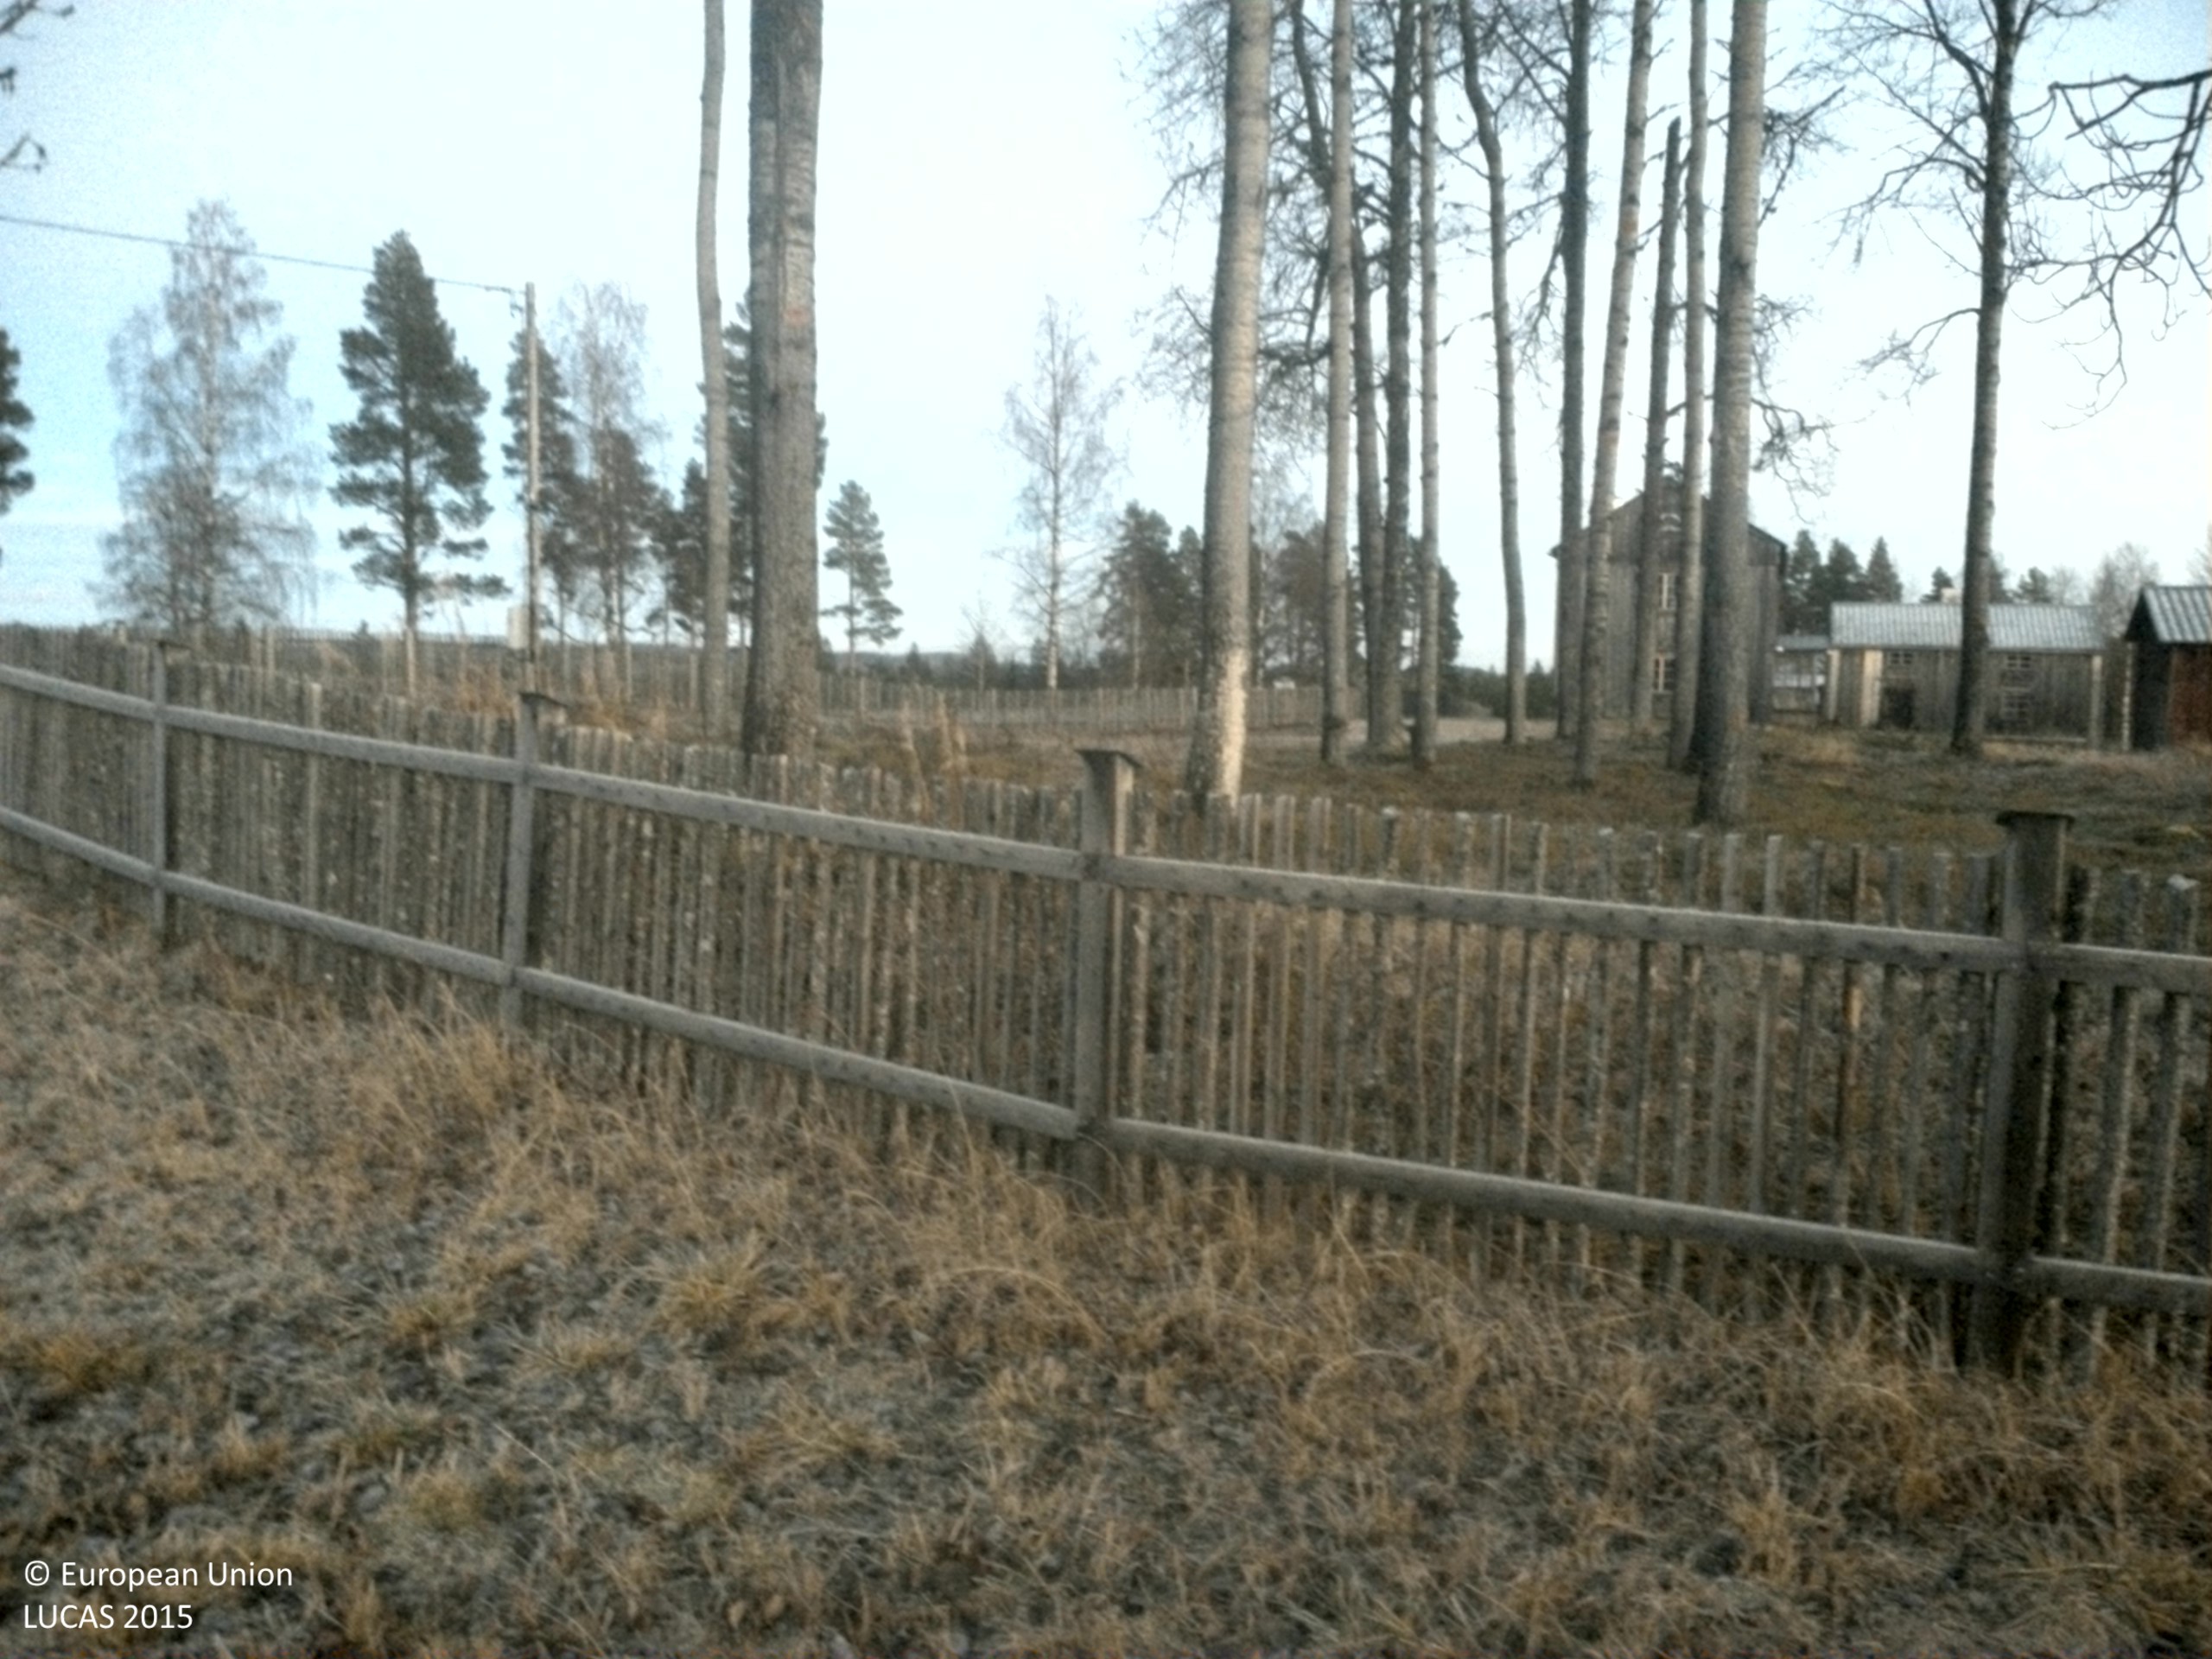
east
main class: Cropland
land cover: Mixed cereals for fodder
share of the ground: > 75 %
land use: Agriculture (excluding fallow land and kitchen gardens)
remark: Harvested field
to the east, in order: Mixed cereals for fodder; Fences; Broadleaved woodland; Paved roads, cycling and walking lanes; Grassland without tree/shrub cover; Fences; Grassland without tree/shrub cover; Grassland with sparse tree/shrub cover; Fences; Spruce dominated coniferous woodland
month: November
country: SE
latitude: 63.7987
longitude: 15.9207
